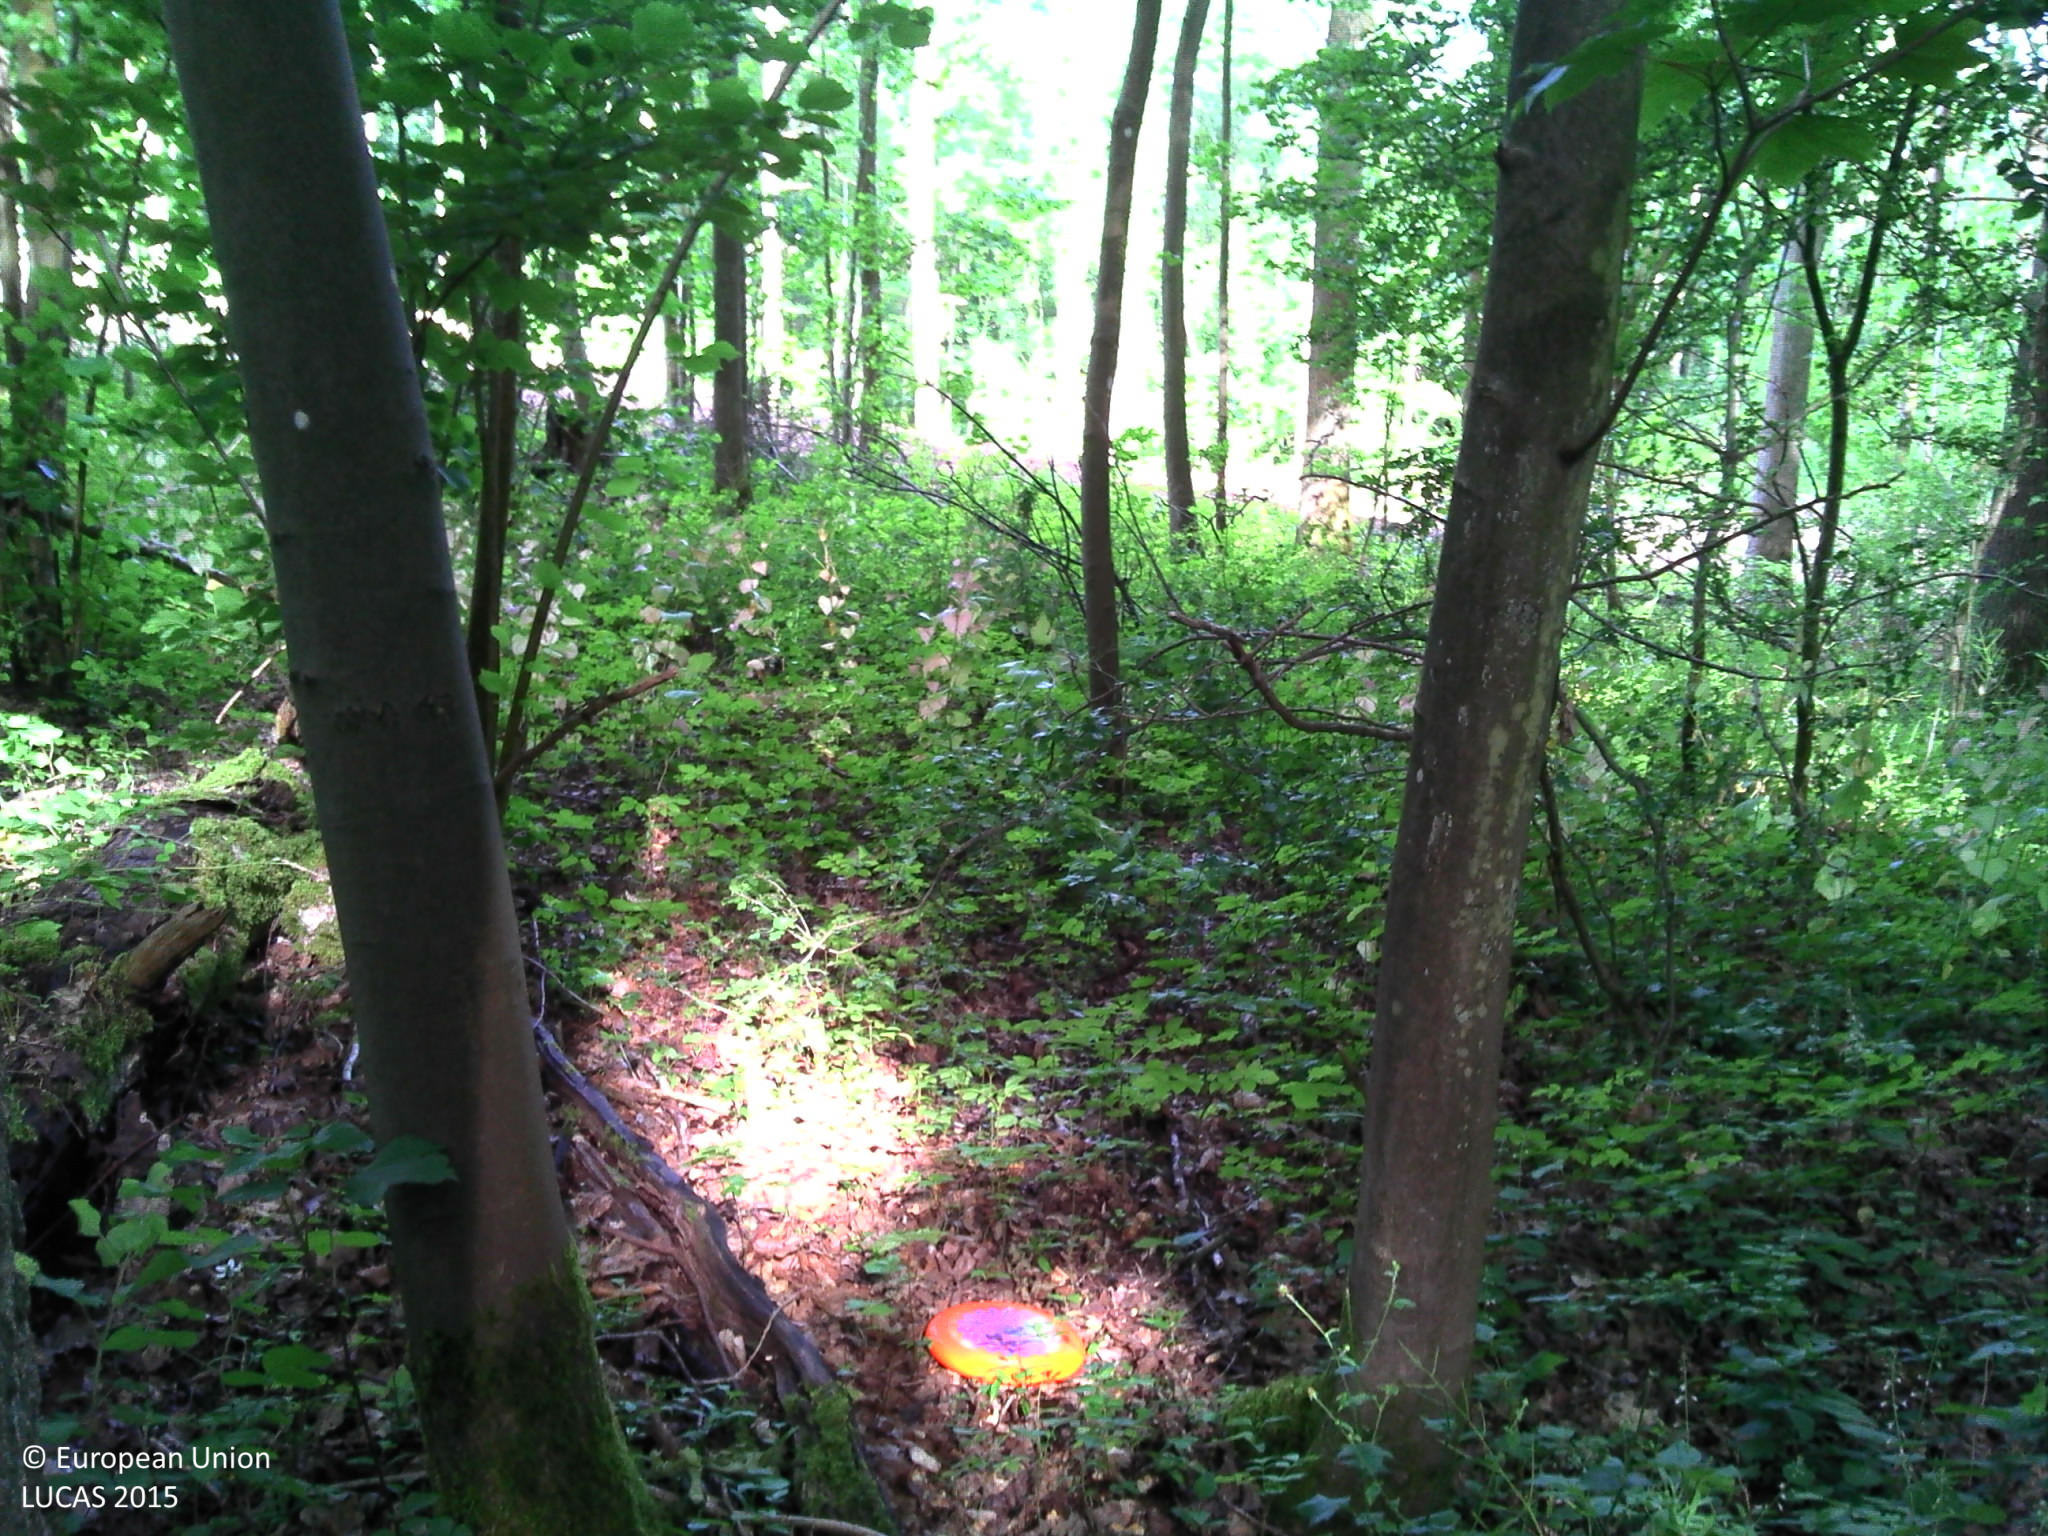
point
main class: Woodland
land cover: Broadleaved woodland
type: mesophytic deciduous forest
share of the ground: > 75 %
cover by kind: broadleaved forest trees 100 %
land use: Forestry
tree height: > 5 m
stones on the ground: < 10 %
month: June
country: BE
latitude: 50.2865
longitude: 4.9023
